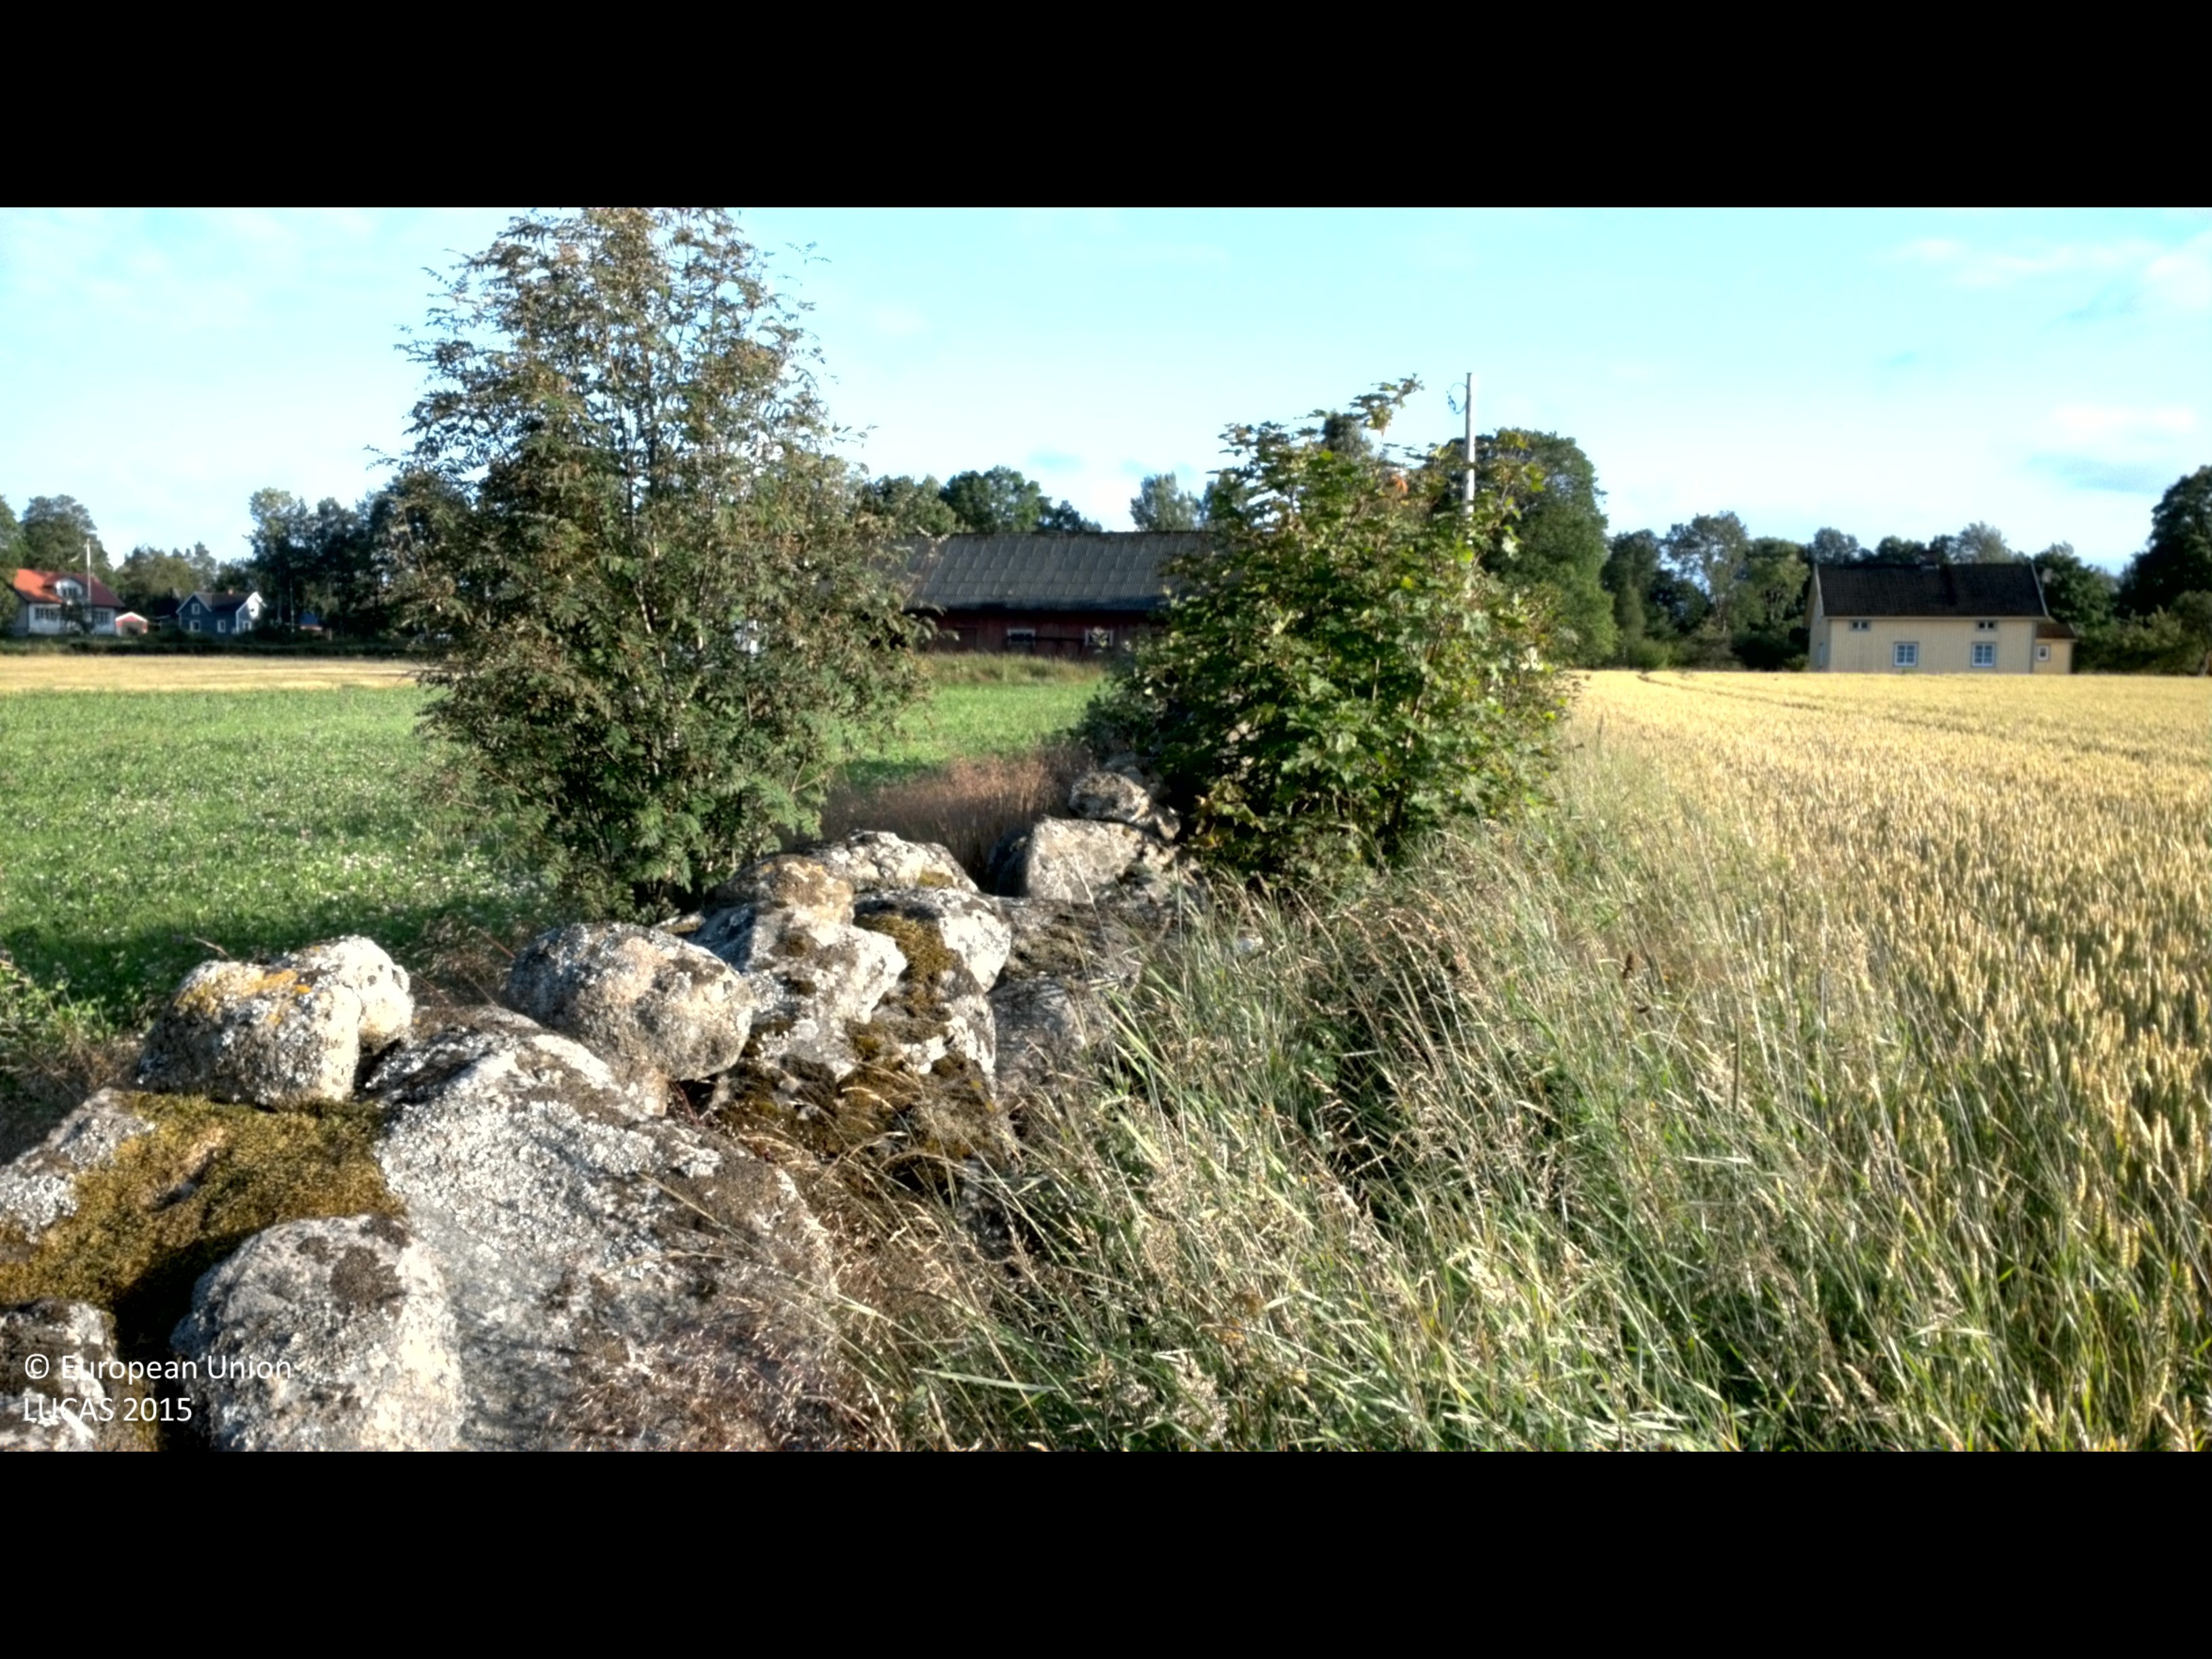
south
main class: Cropland
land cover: Common wheat
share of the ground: > 75 %
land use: Agriculture (excluding fallow land and kitchen gardens)
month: July
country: SE
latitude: 56.8142
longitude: 13.8461
